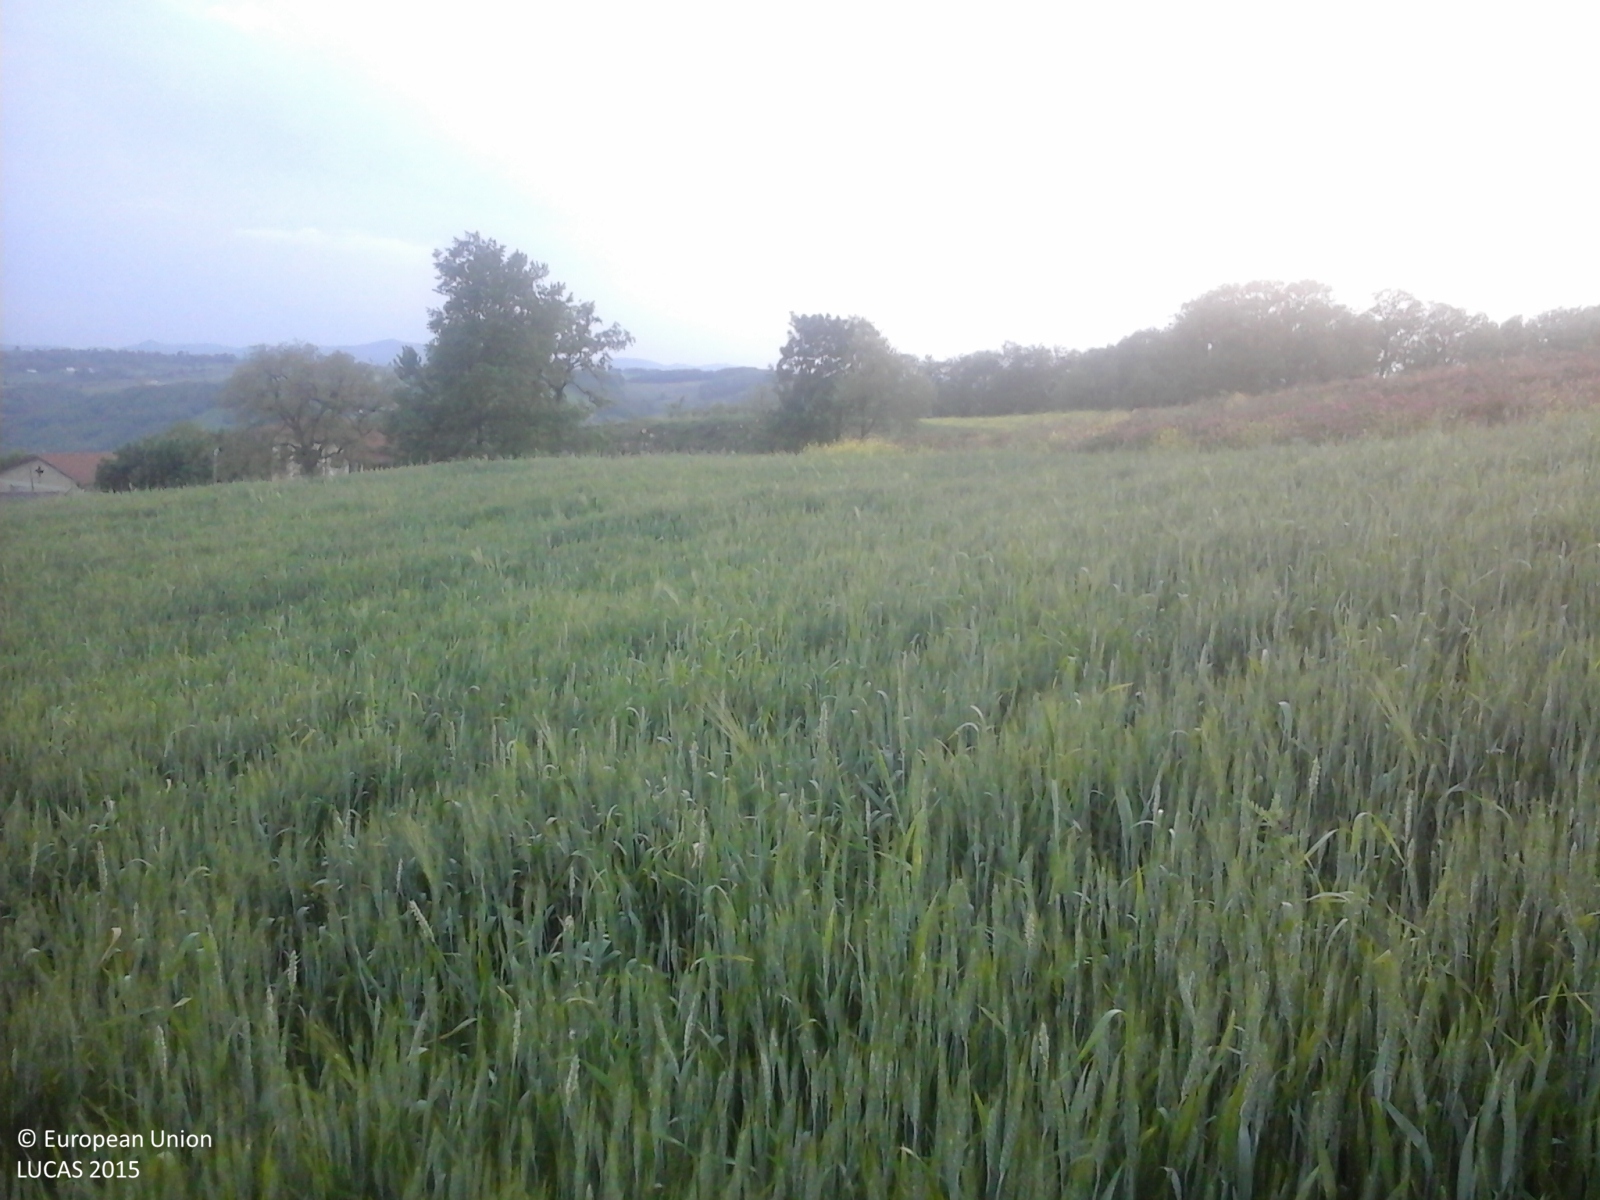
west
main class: Grassland
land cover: Spontaneously vegetated surfaces
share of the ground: > 75 %
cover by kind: herbaceous plants 100 %
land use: Agriculture (excluding fallow land and kitchen gardens)
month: May
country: IT
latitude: 41.3818
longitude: 14.8018
